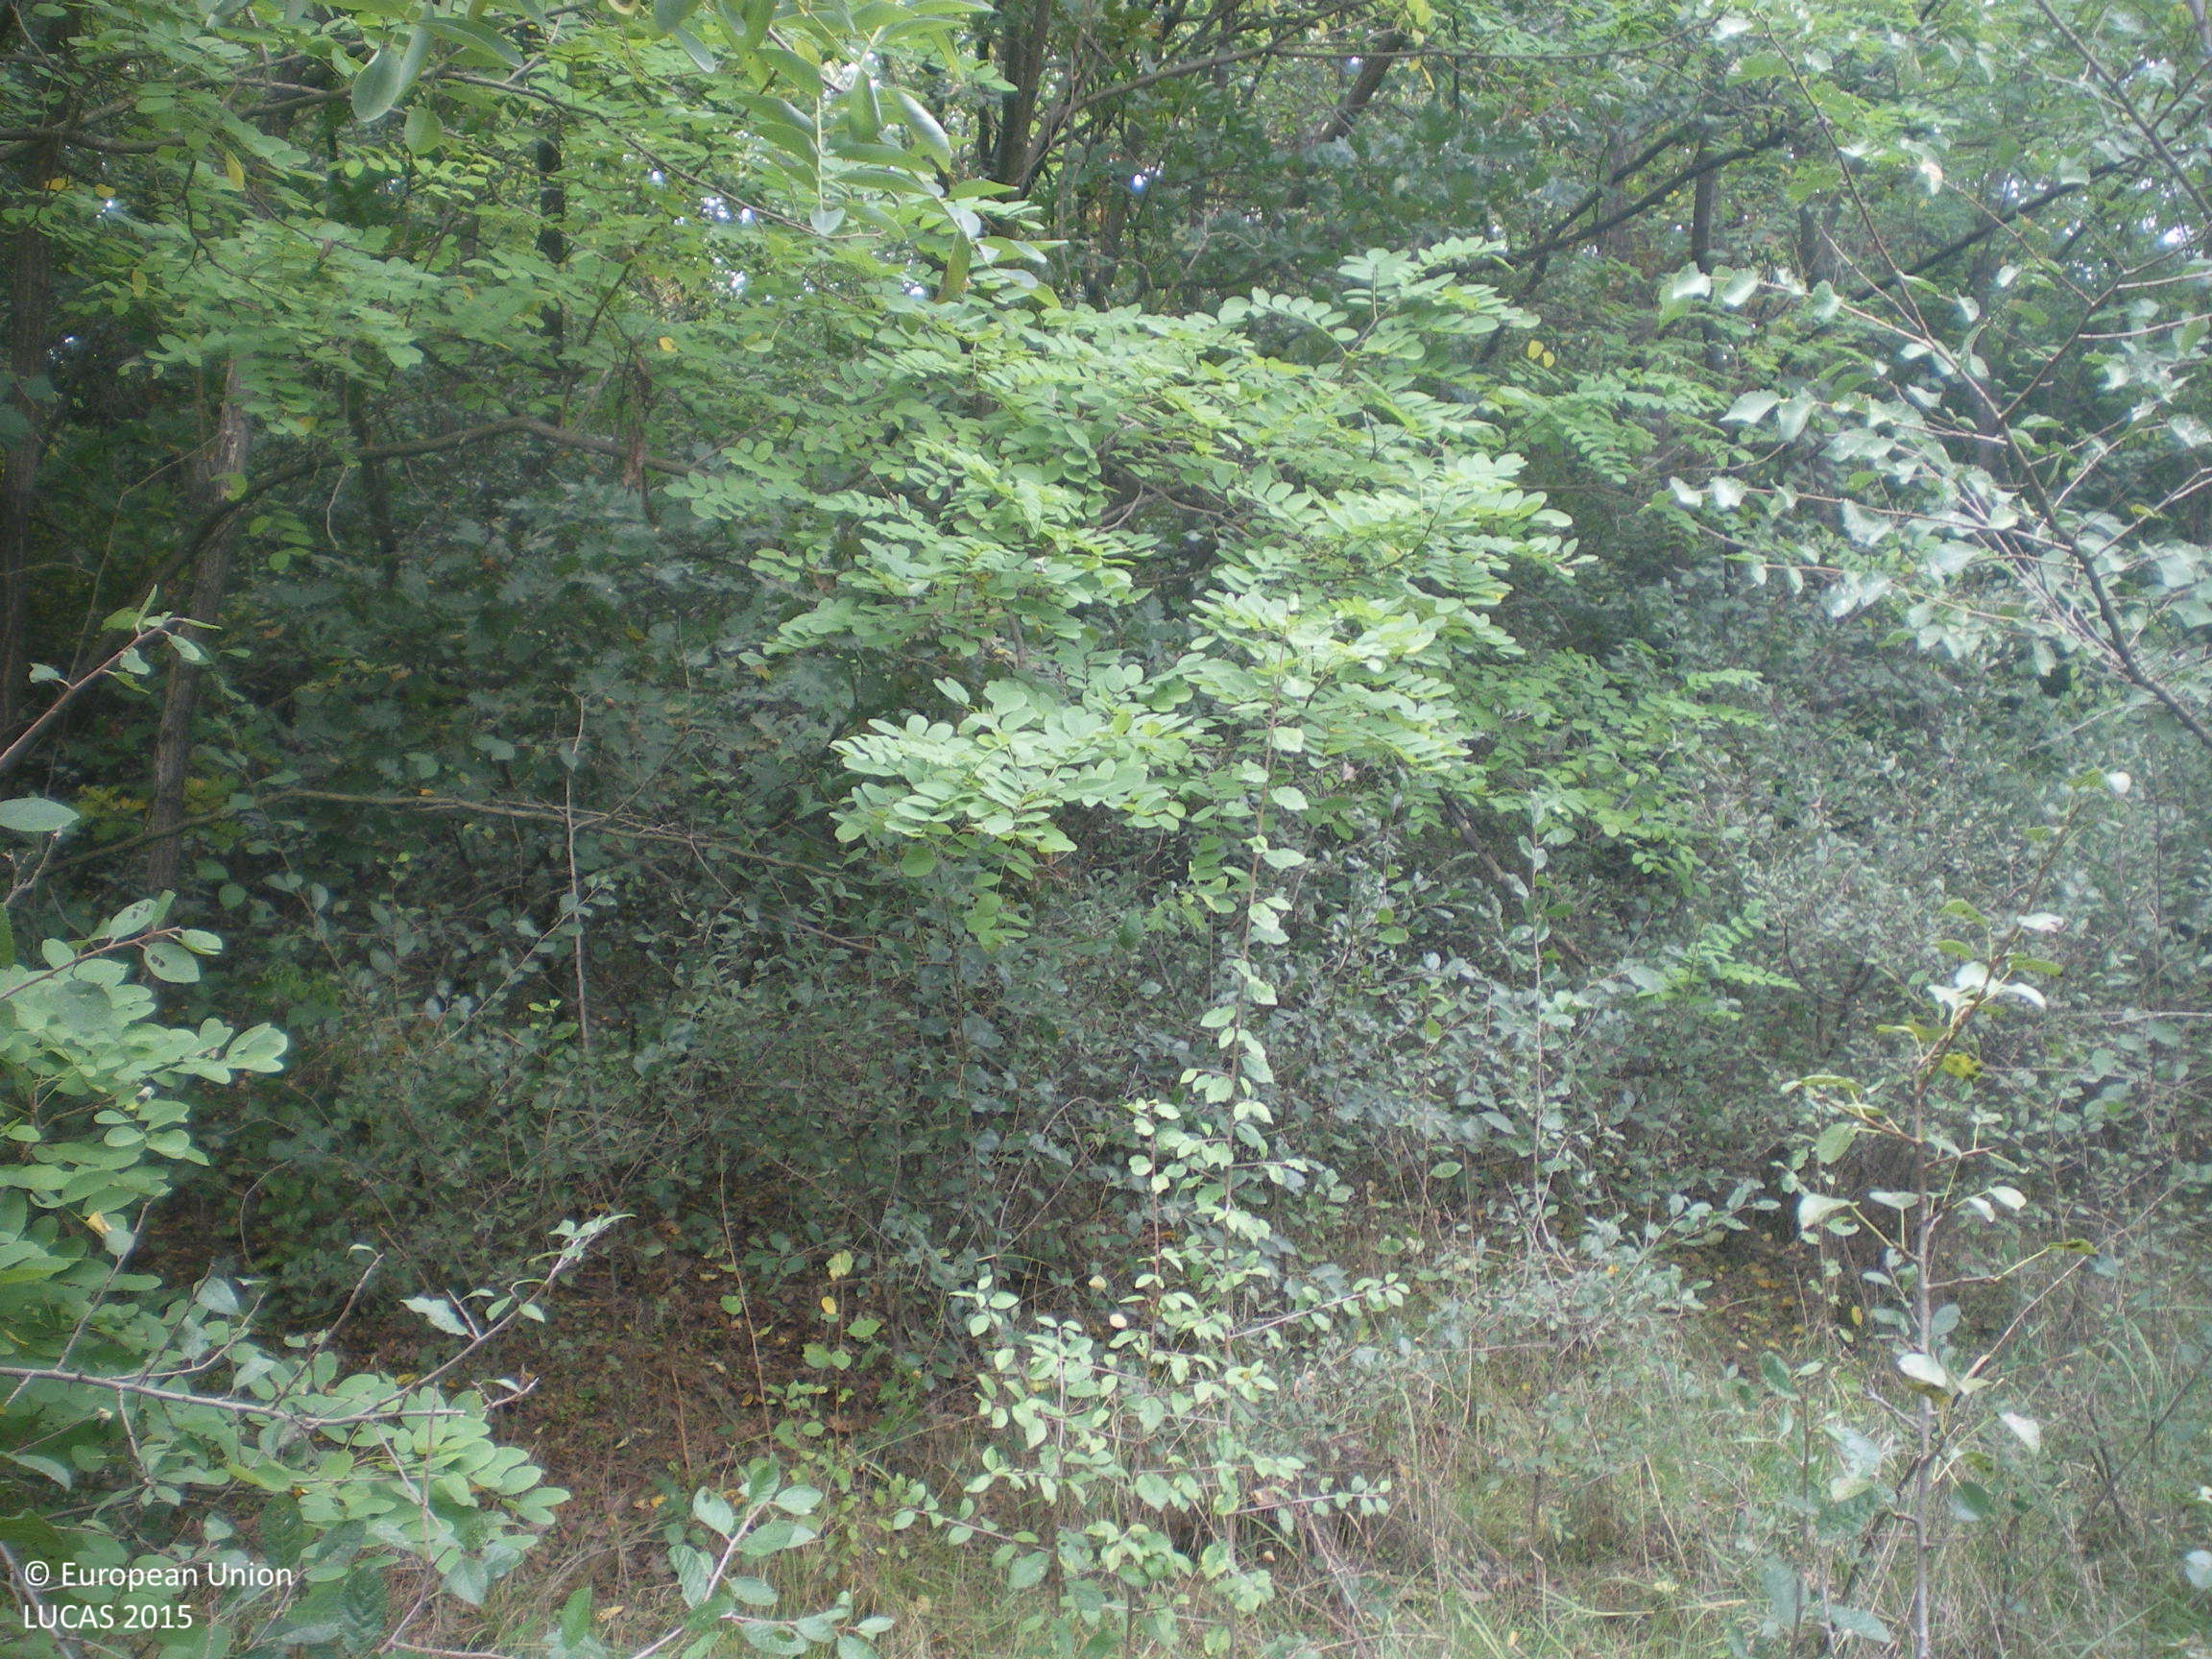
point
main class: Woodland
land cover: Broadleaved woodland
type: mesophytic deciduous forest
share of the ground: > 75 %
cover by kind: broadleaved forest trees 95 %, unconsolidated bare surface 5 %
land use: Forestry
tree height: > 5 m
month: October
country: BG
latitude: 42.0531
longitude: 25.7657
